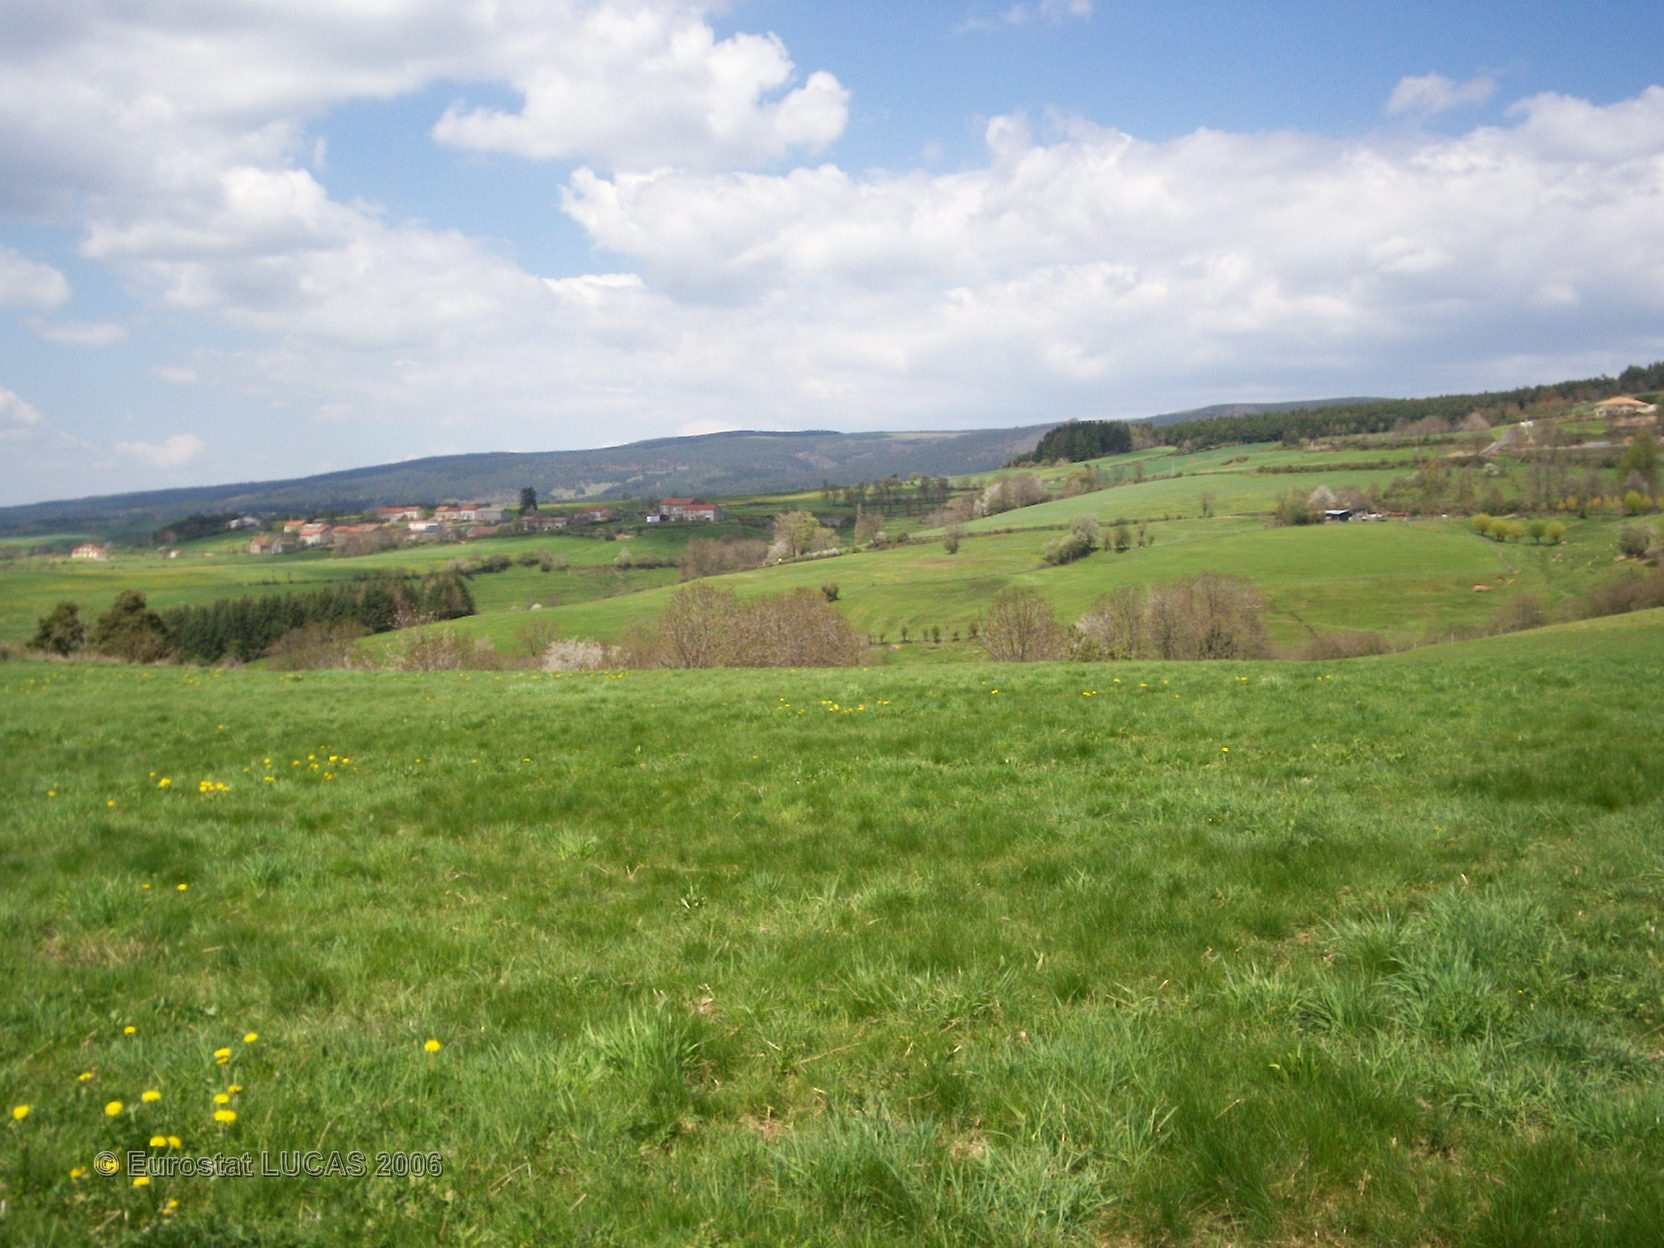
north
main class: Grassland
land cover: Grassland without tree/shrub cover
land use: Agriculture (excluding fallow land and kitchen gardens)
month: May
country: FR
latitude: 44.9821
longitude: 3.2689
